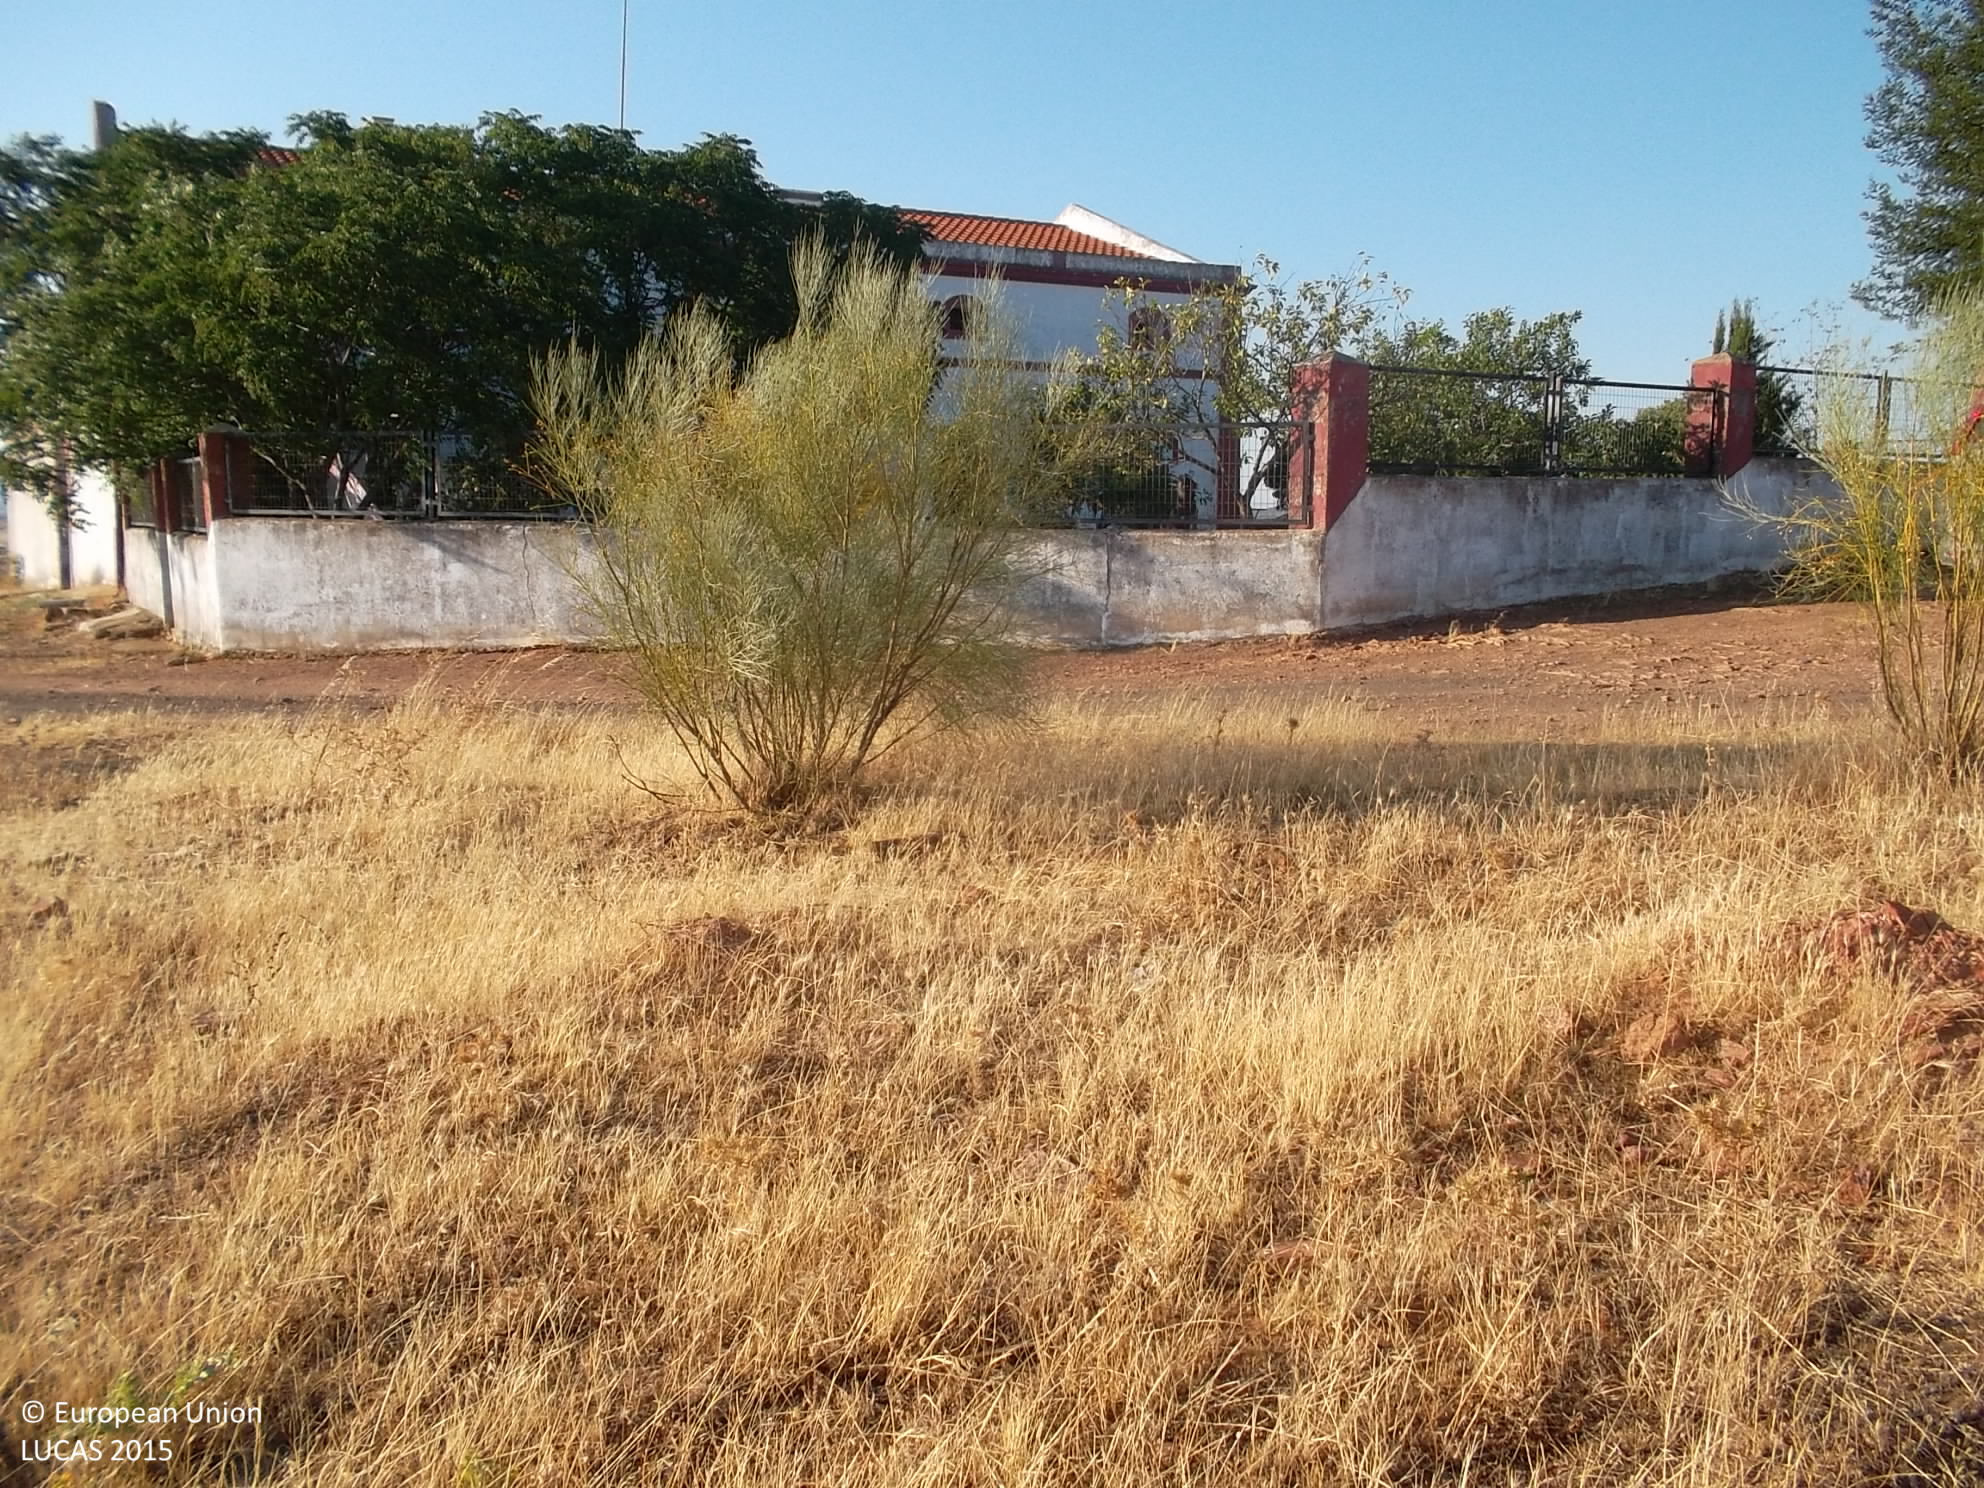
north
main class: Grassland
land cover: Grassland with sparse tree/shrub cover
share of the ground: > 75 %
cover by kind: herbaceous plants 90 %, broadleaved forest trees 5 %, shrubs 5 %
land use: Agriculture (excluding fallow land and kitchen gardens)
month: July
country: ES
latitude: 38.5338
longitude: -5.8150
